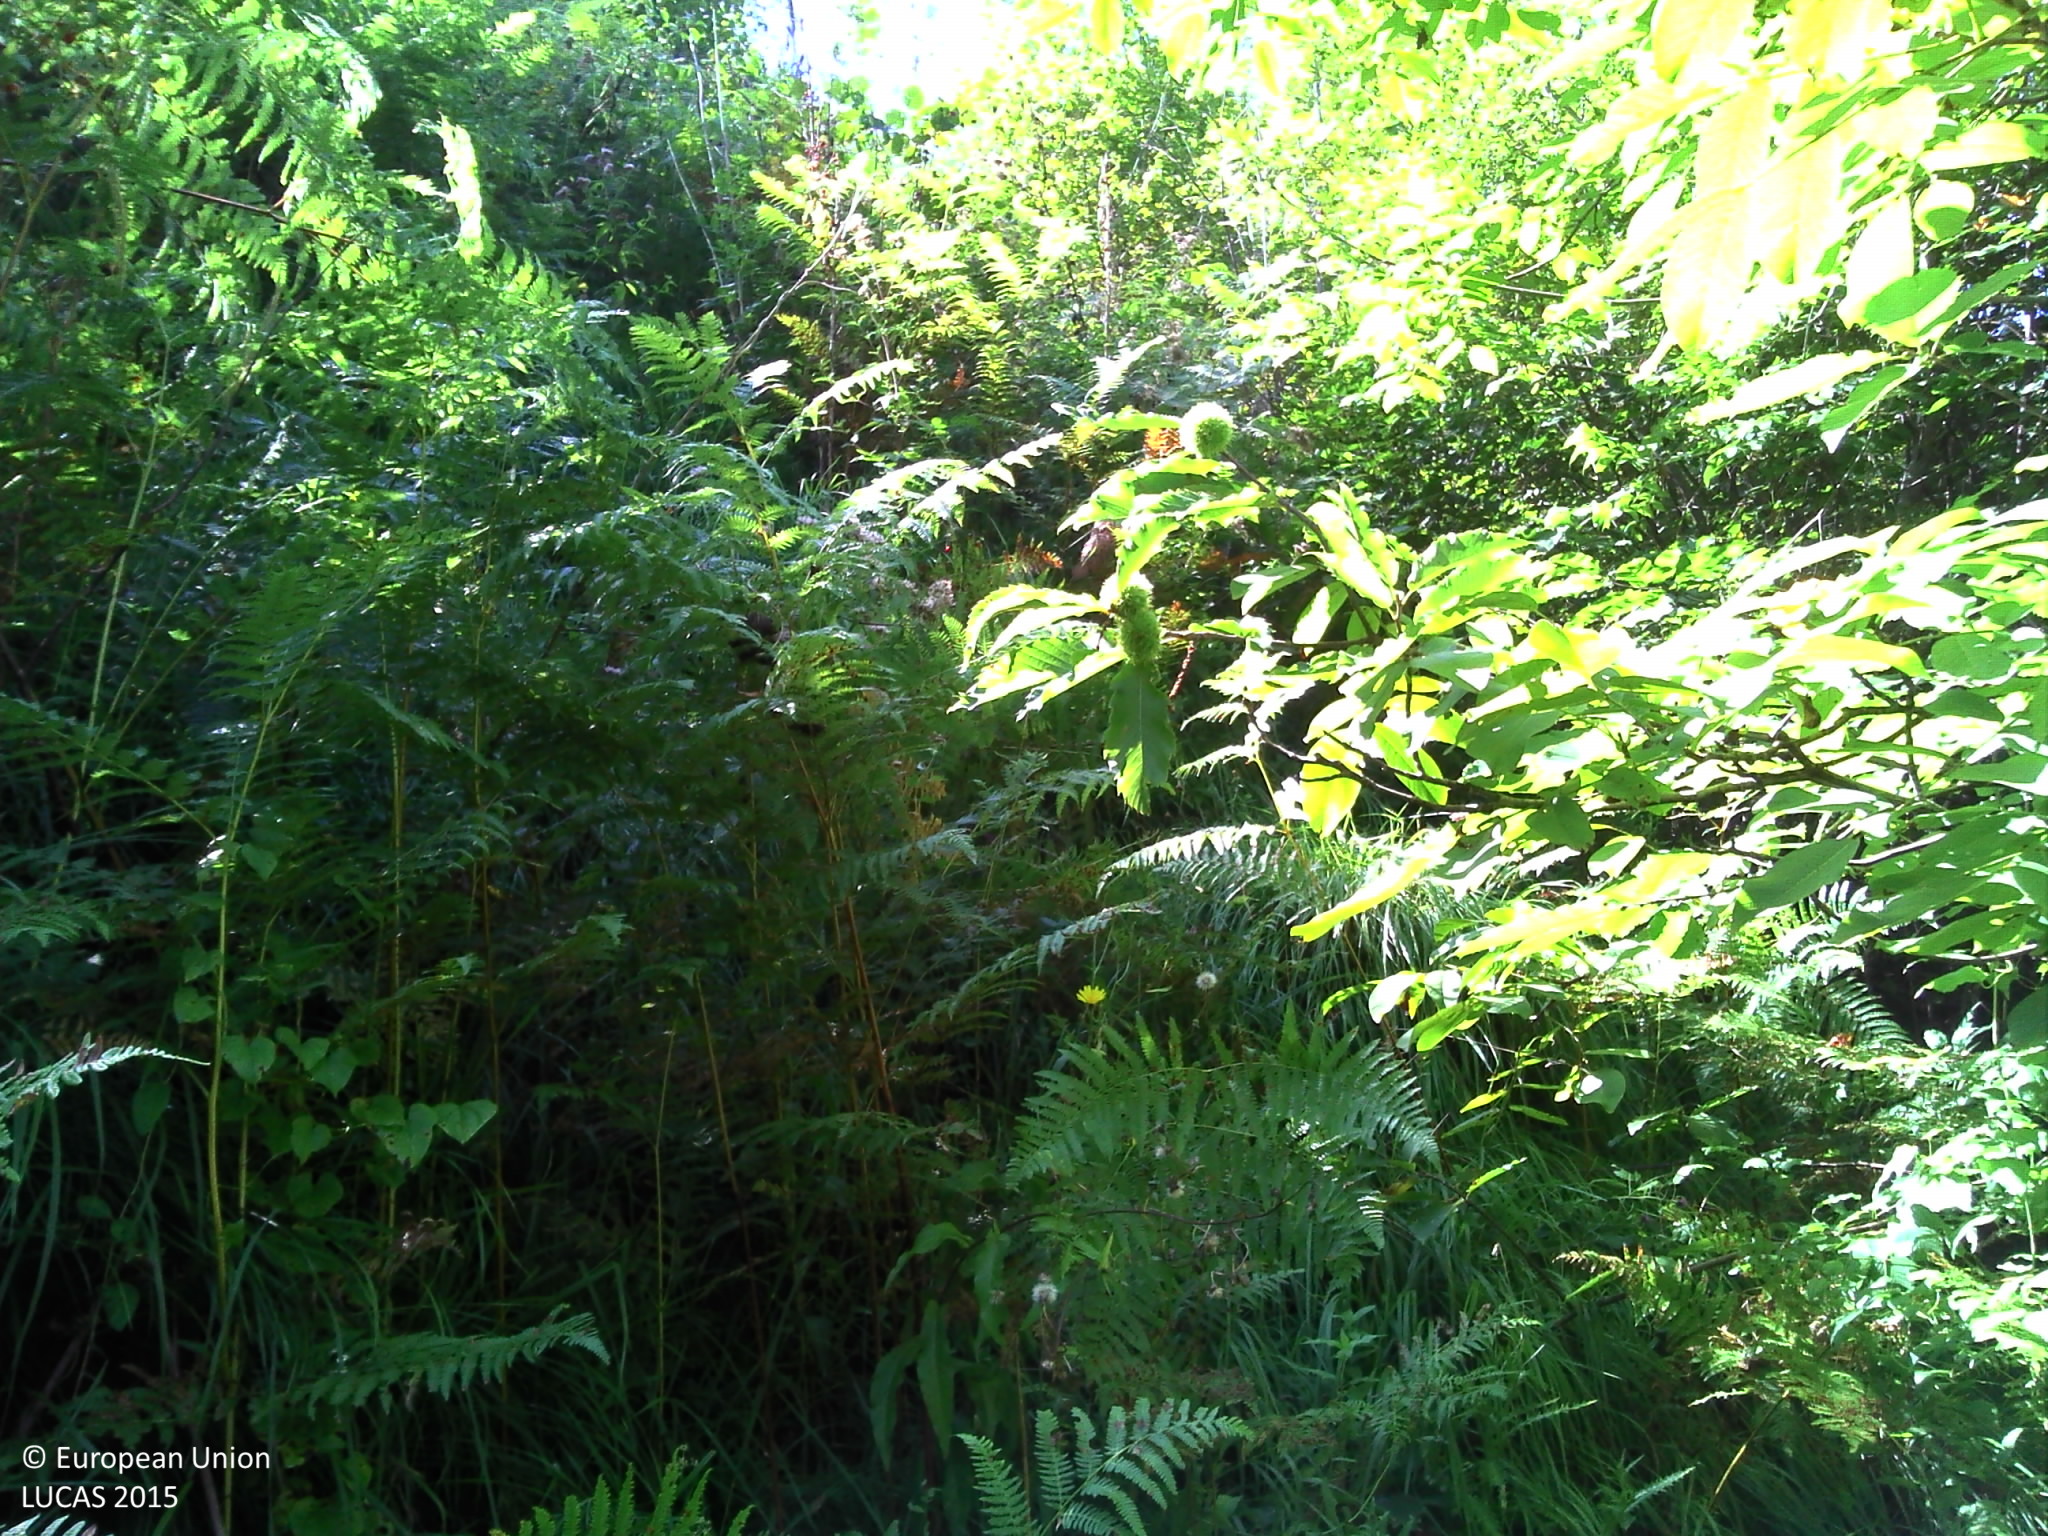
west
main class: Woodland
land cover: Broadleaved woodland
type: acidophilous oak and oak-birch forest
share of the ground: 50 - 75 %
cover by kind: broadleaved forest trees 60 %, herbaceous plants 30 %, shrubs 5 %, consolidated bare surface 5 %
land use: Forestry
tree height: > 5 m
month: September
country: FR
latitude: 43.0141
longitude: -0.8673
